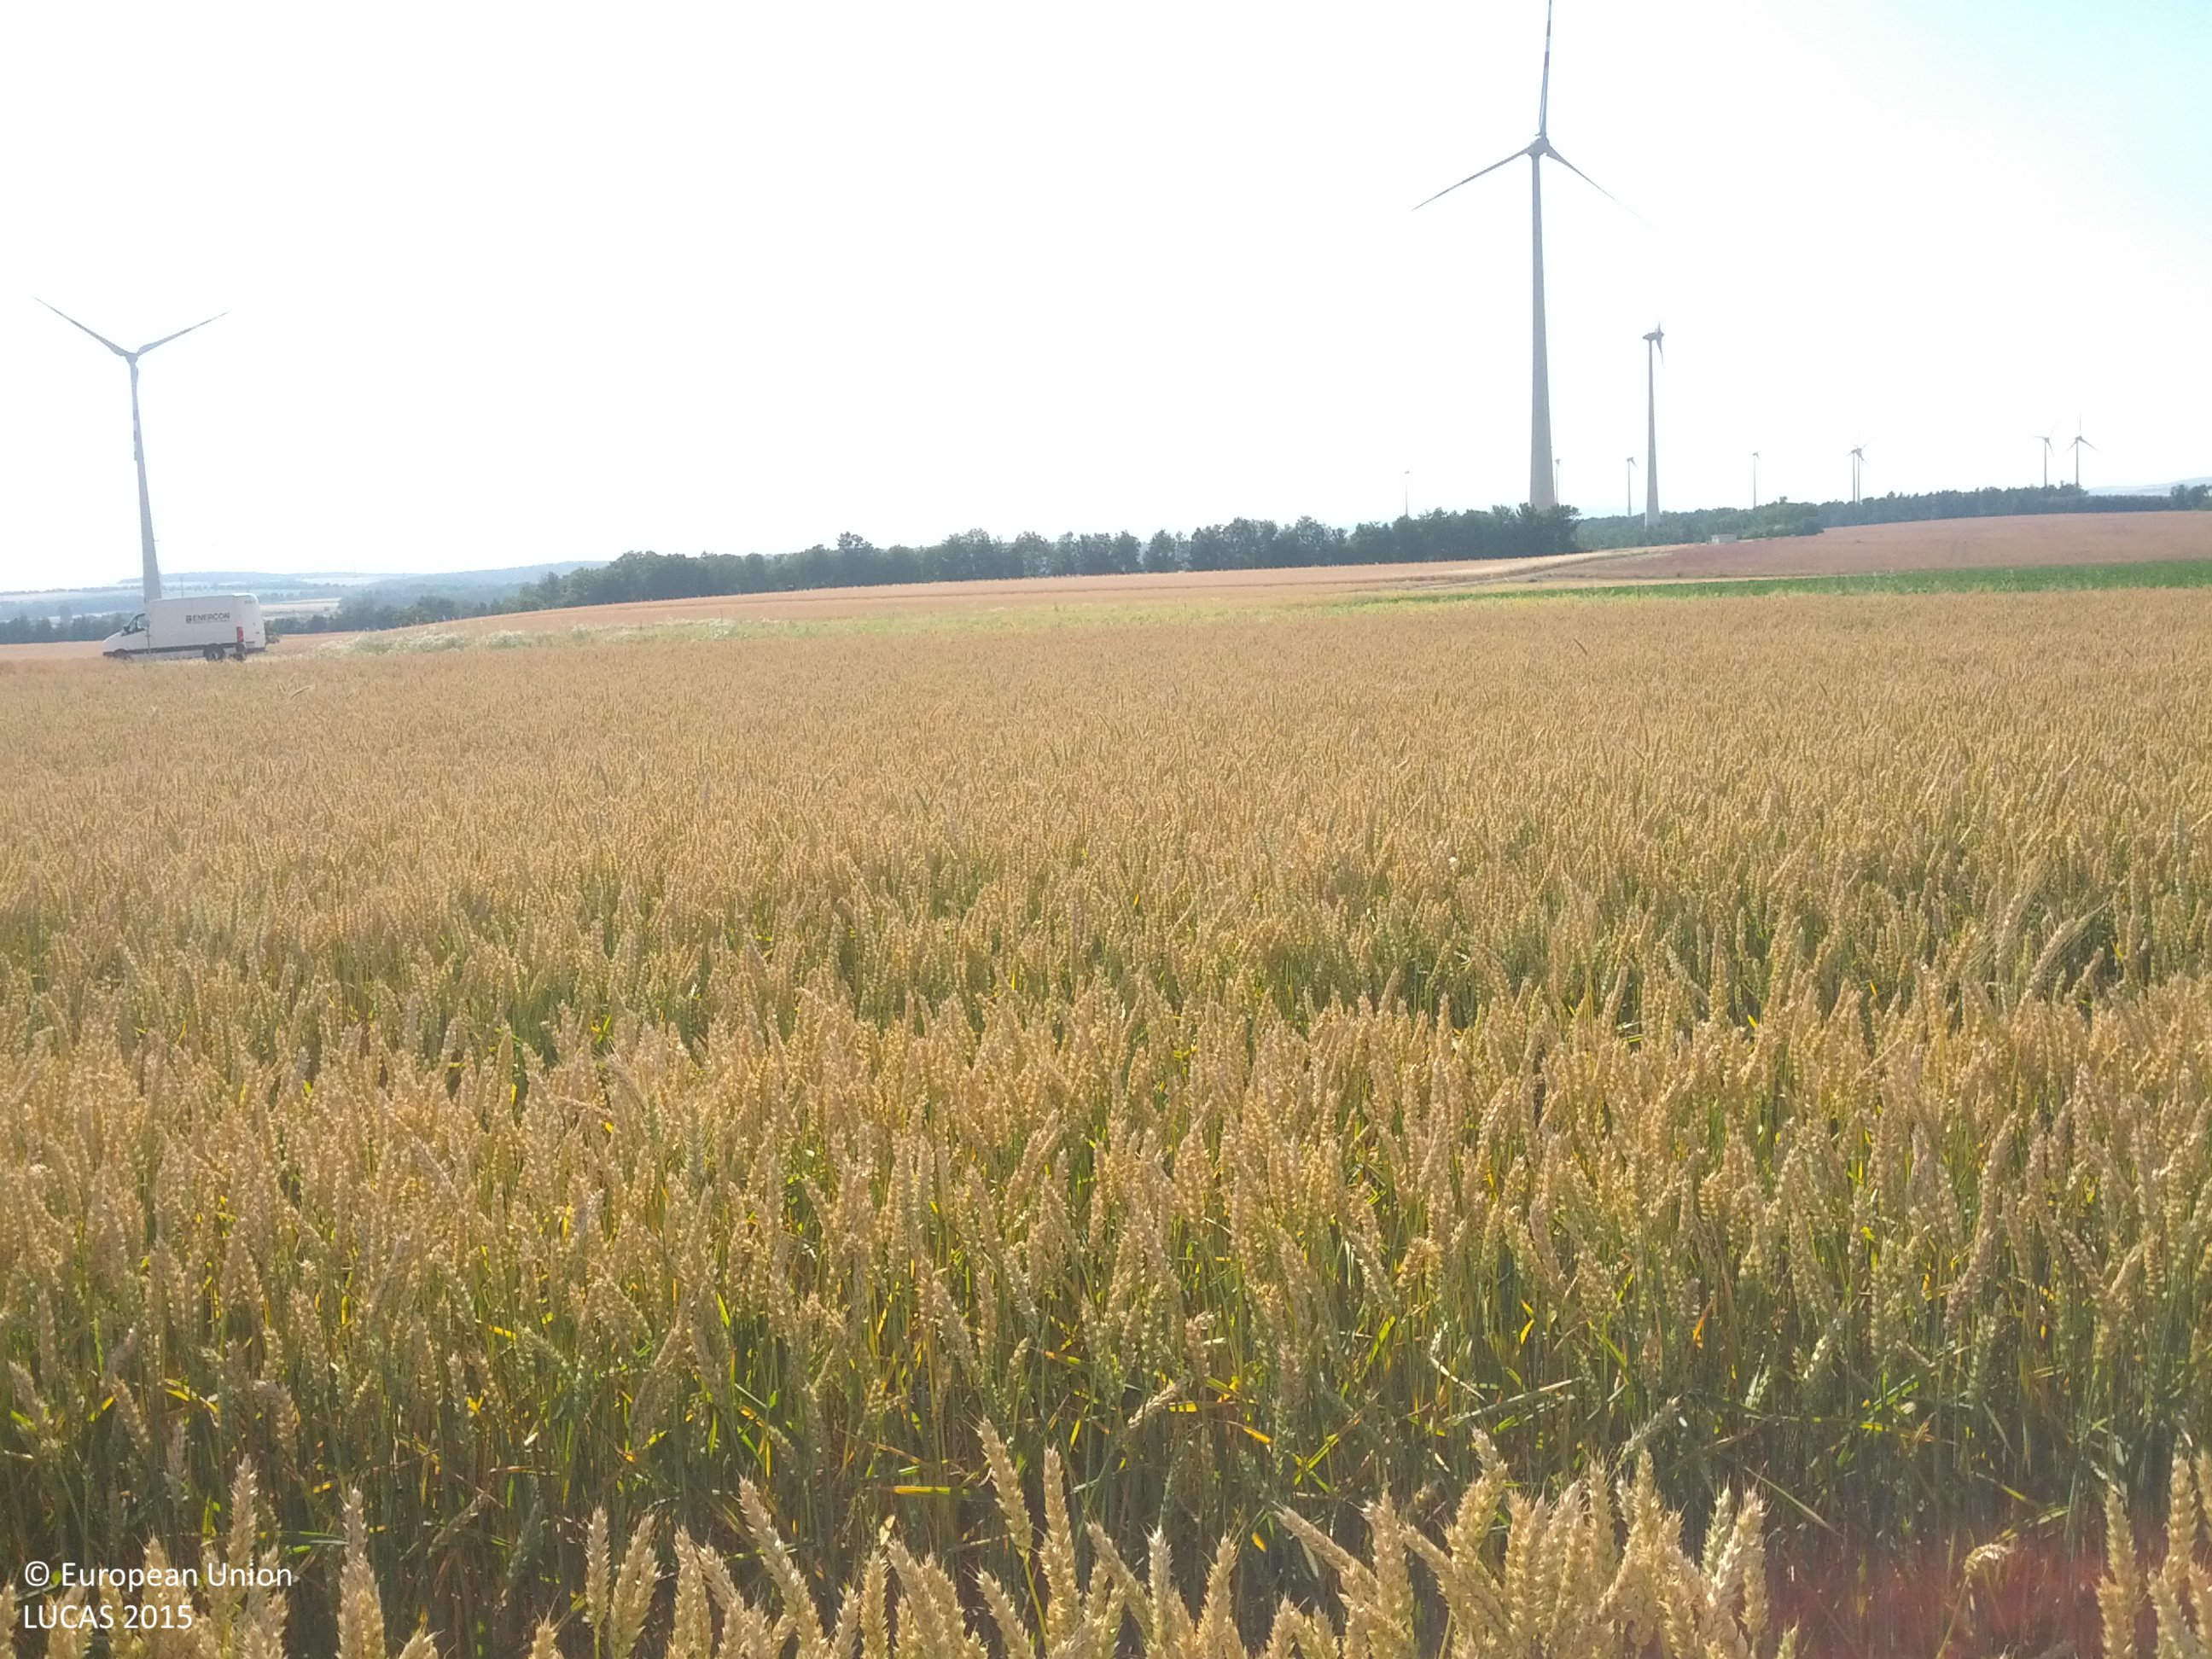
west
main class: Cropland
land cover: Common wheat
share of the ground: > 75 %
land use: Agriculture (excluding fallow land and kitchen gardens)
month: July
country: AT
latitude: 48.5279
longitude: 16.6554
